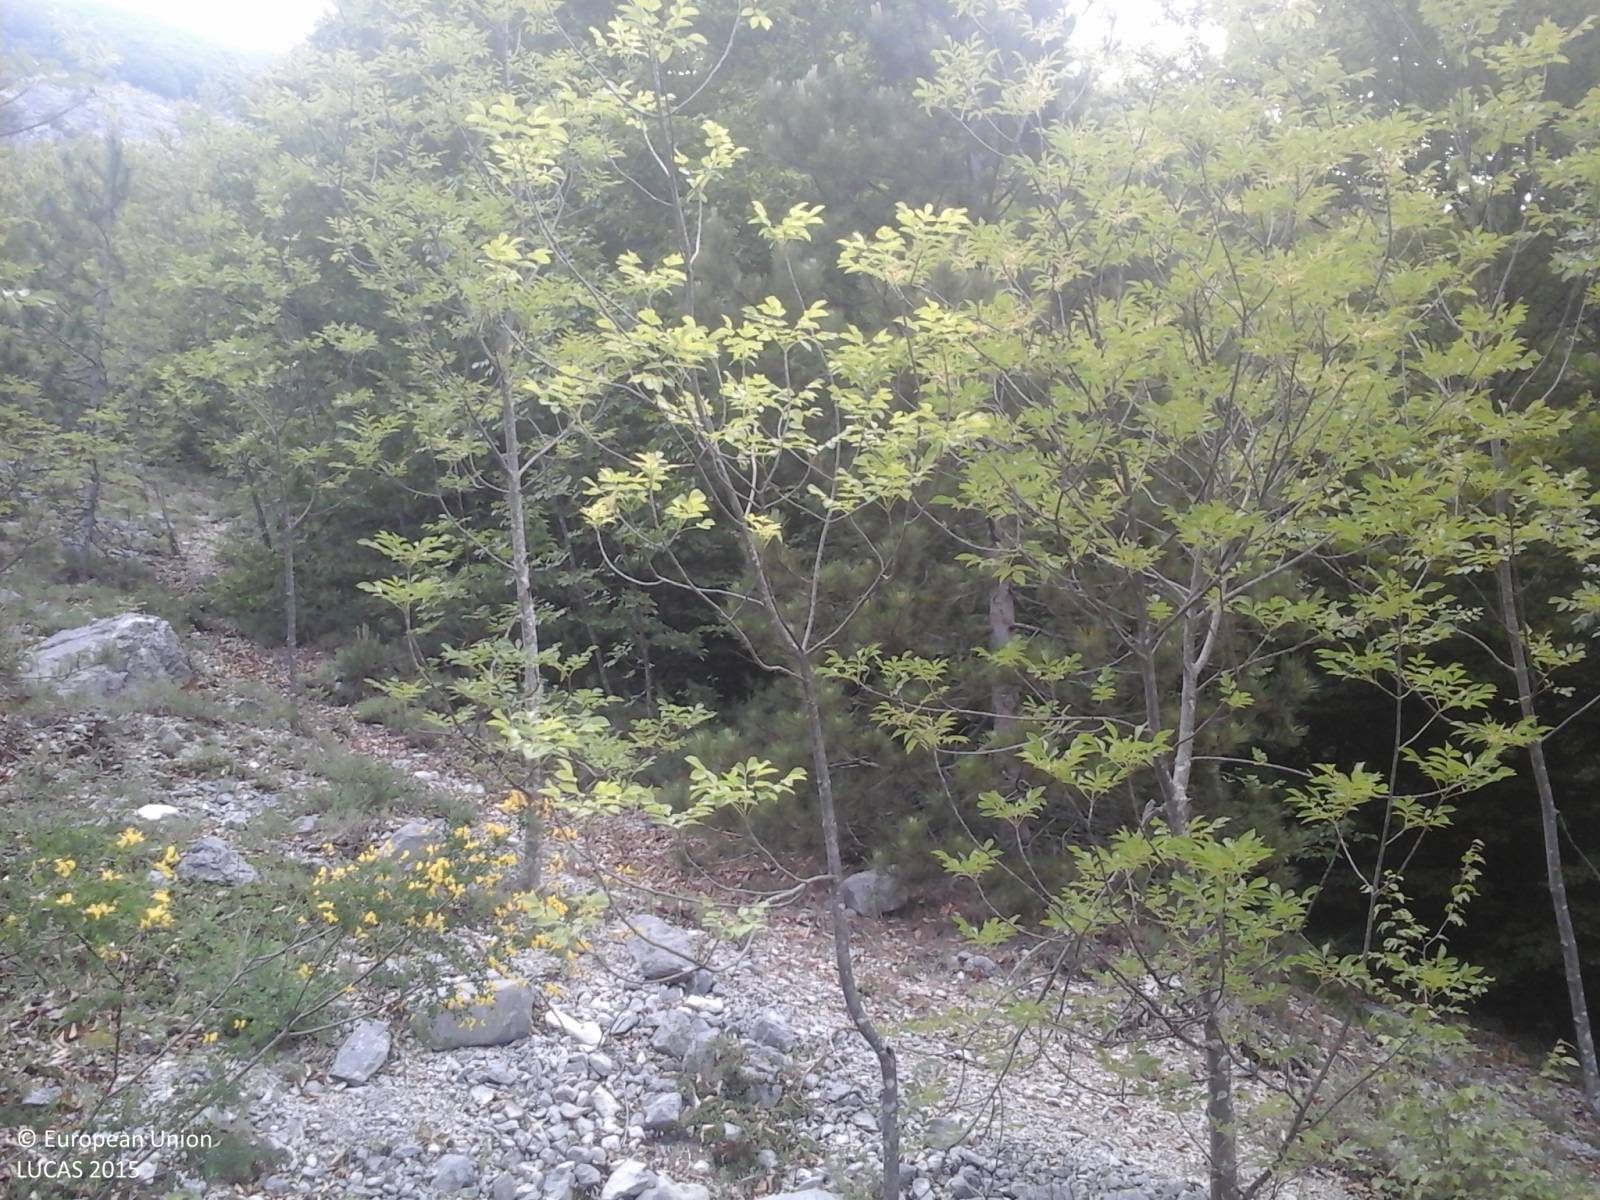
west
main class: Woodland
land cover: Broadleaved woodland
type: mountainous beech forest
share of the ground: > 75 %
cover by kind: broadleaved forest trees 80 %, unconsolidated bare surface 10 %, coniferous forest trees 5 %, shrubs 5 %
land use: Semi-natural and natural areas not in use
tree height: > 5 m
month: June
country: IT
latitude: 41.8919
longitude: 13.3987
